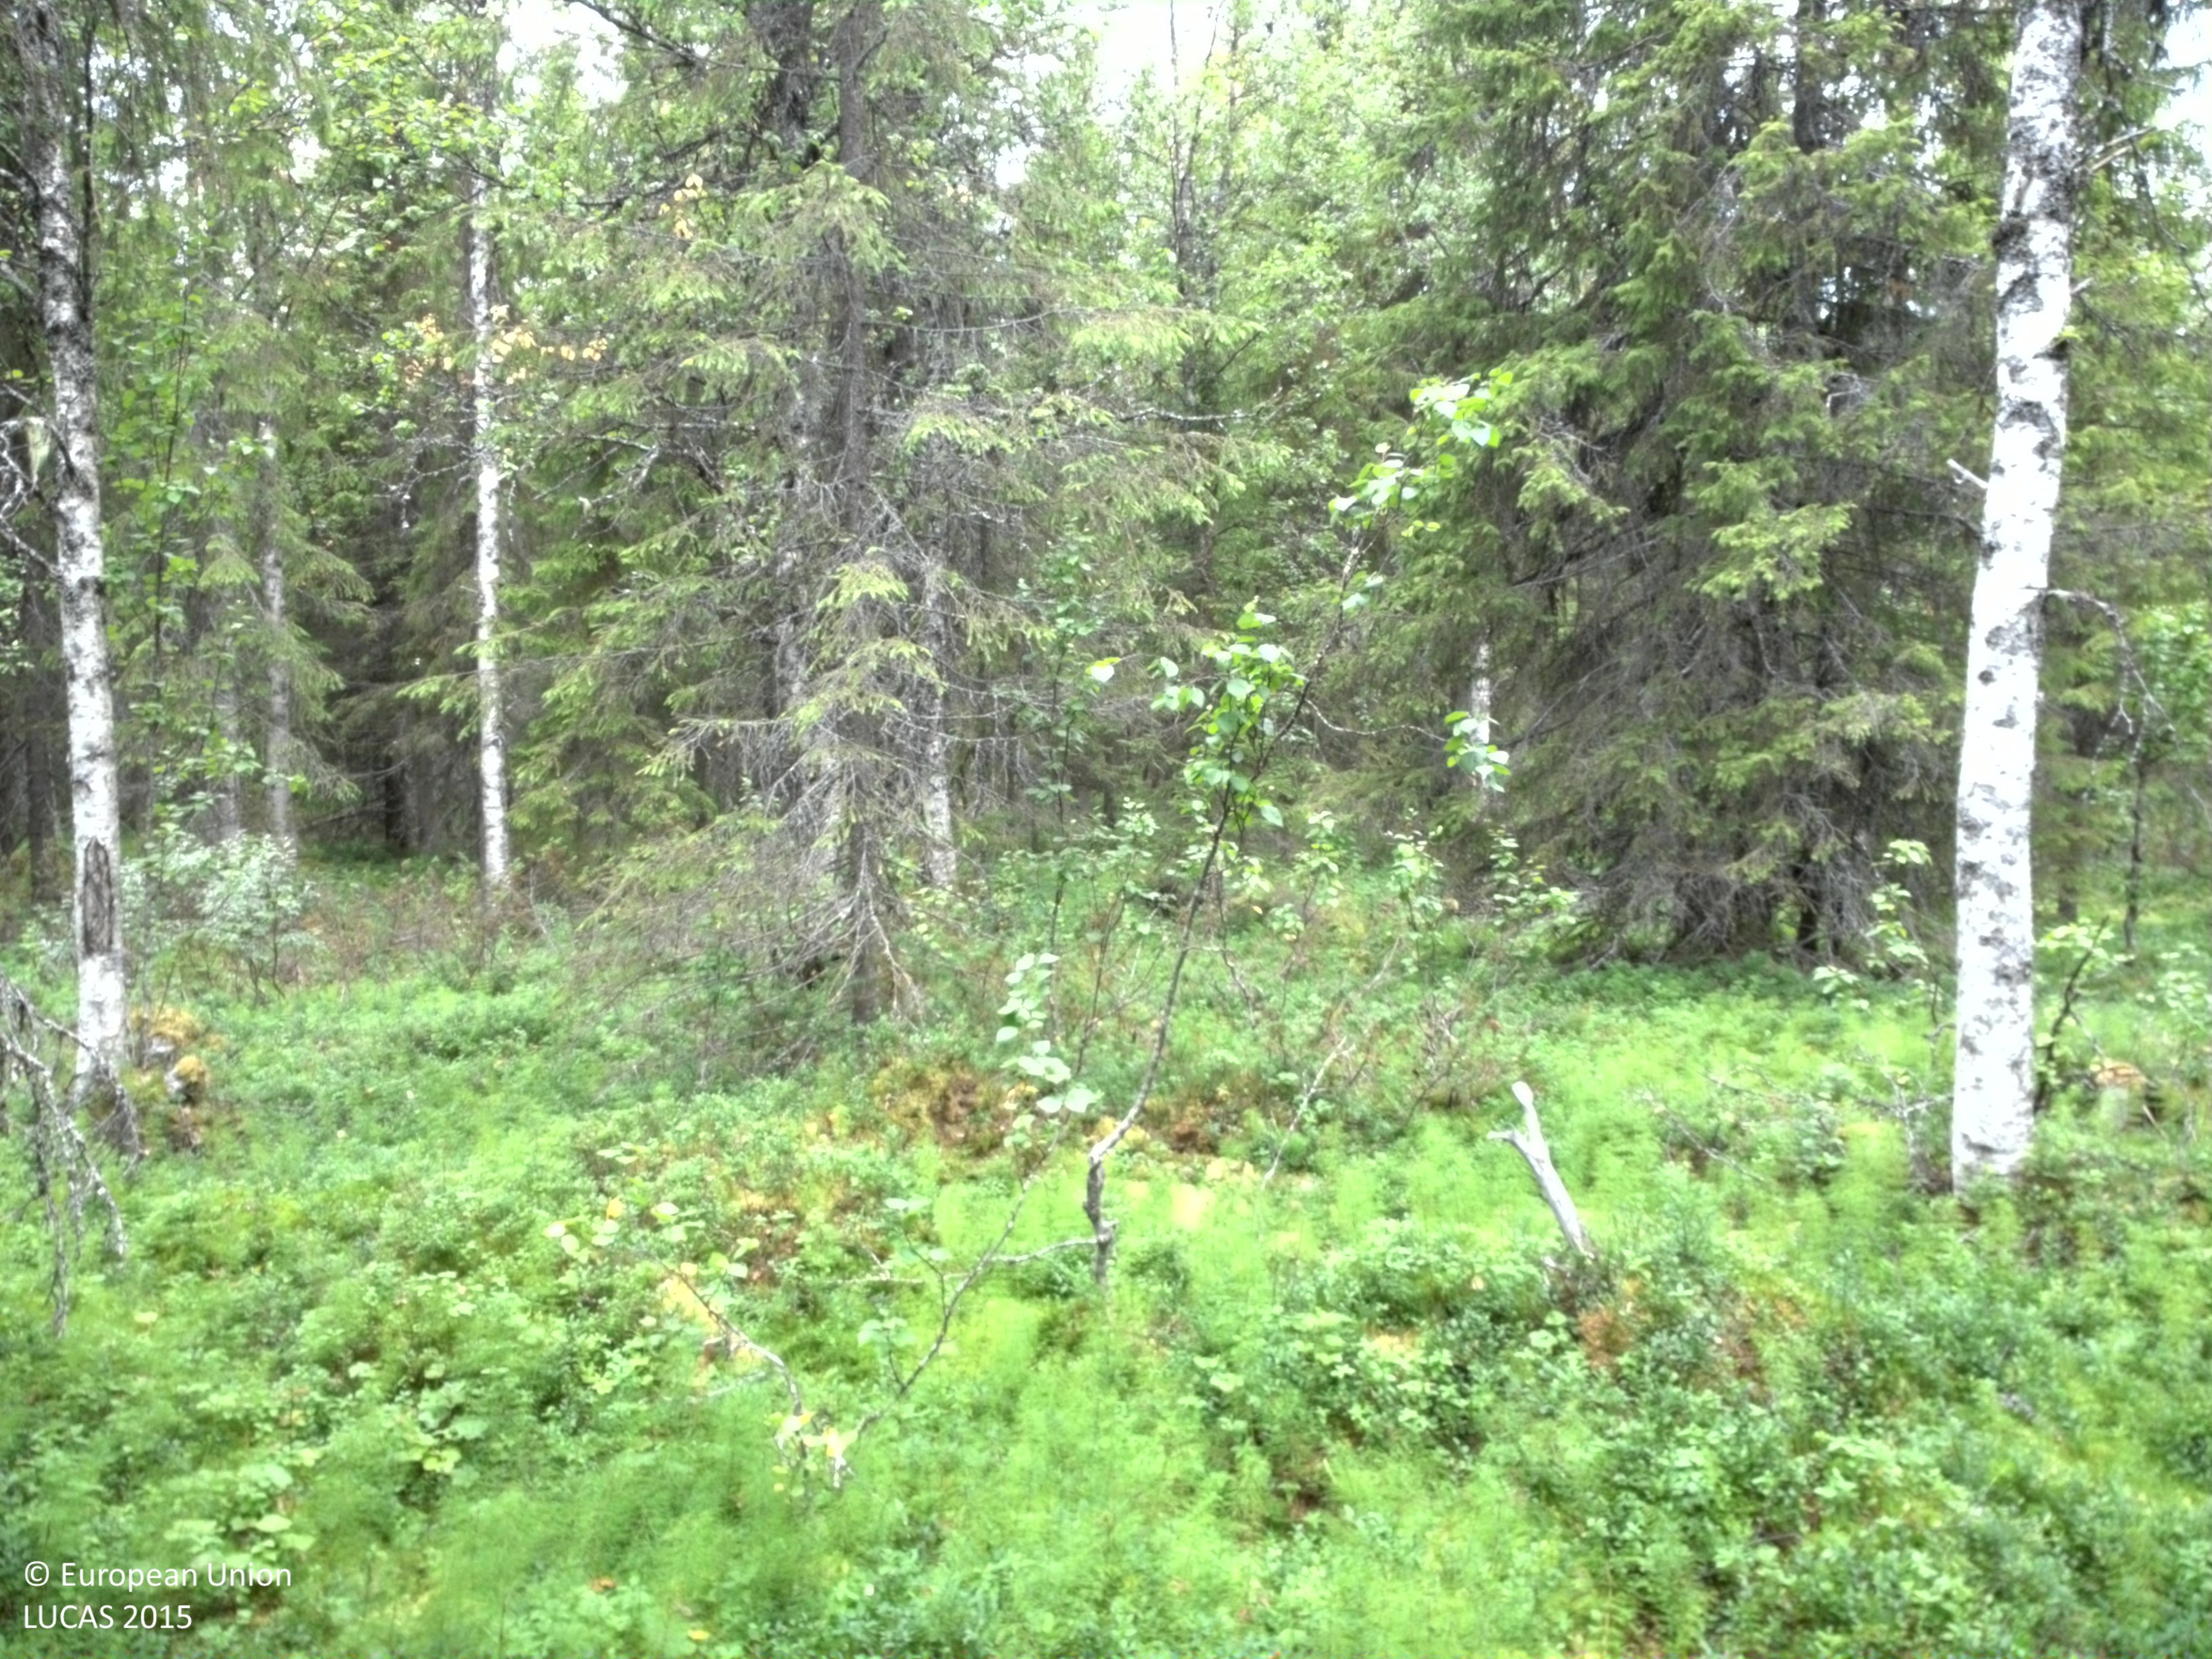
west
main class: Woodland
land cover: Spruce dominated mixed woodland
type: boreal forest
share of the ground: 25 - 50 %
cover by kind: lichens and mosses 35 %, shrubs 20 %, herbaceous plants 20 %, coniferous forest trees 15 %, broadleaved forest trees 10 %
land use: Forestry
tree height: > 5 m
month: August
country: SE
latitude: 64.8605
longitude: 16.5688
